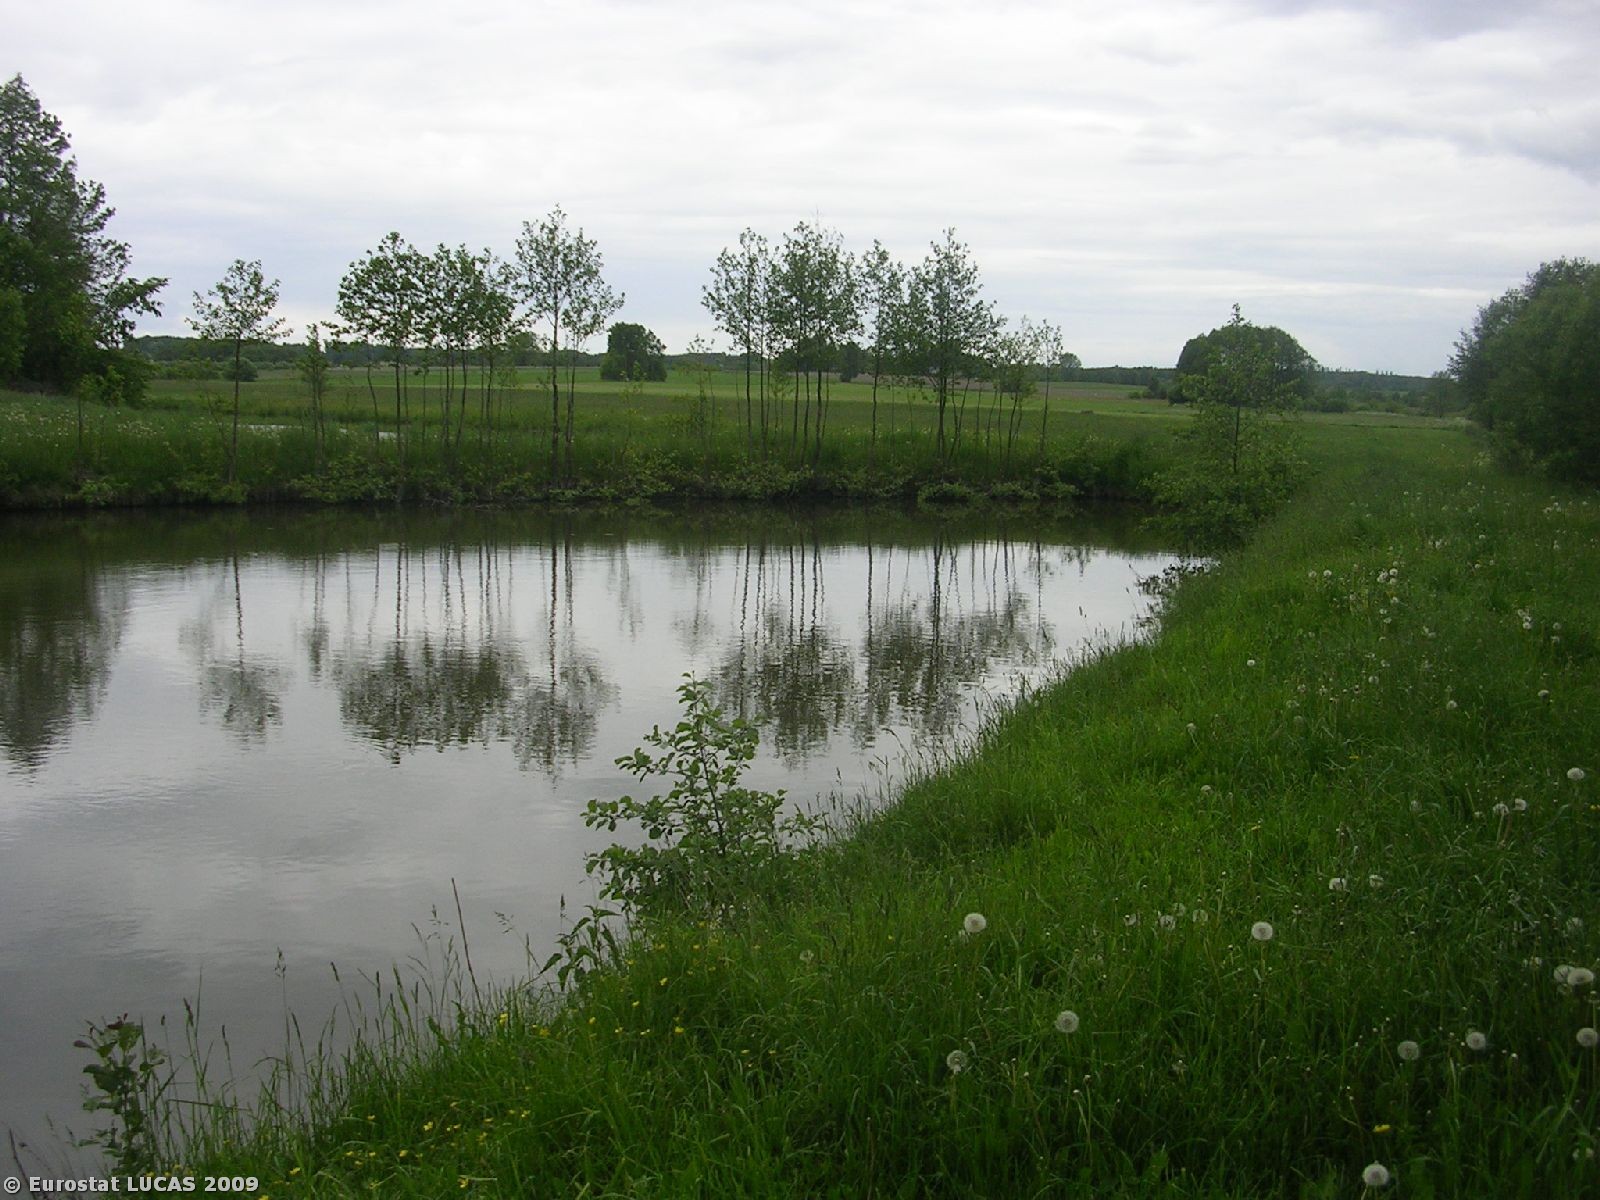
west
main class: Grassland
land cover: Grassland without tree/shrub cover
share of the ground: > 75 %
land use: Aquaculture and fishing
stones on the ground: < 10 %
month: May
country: PL
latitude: 53.5874
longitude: 23.3594
